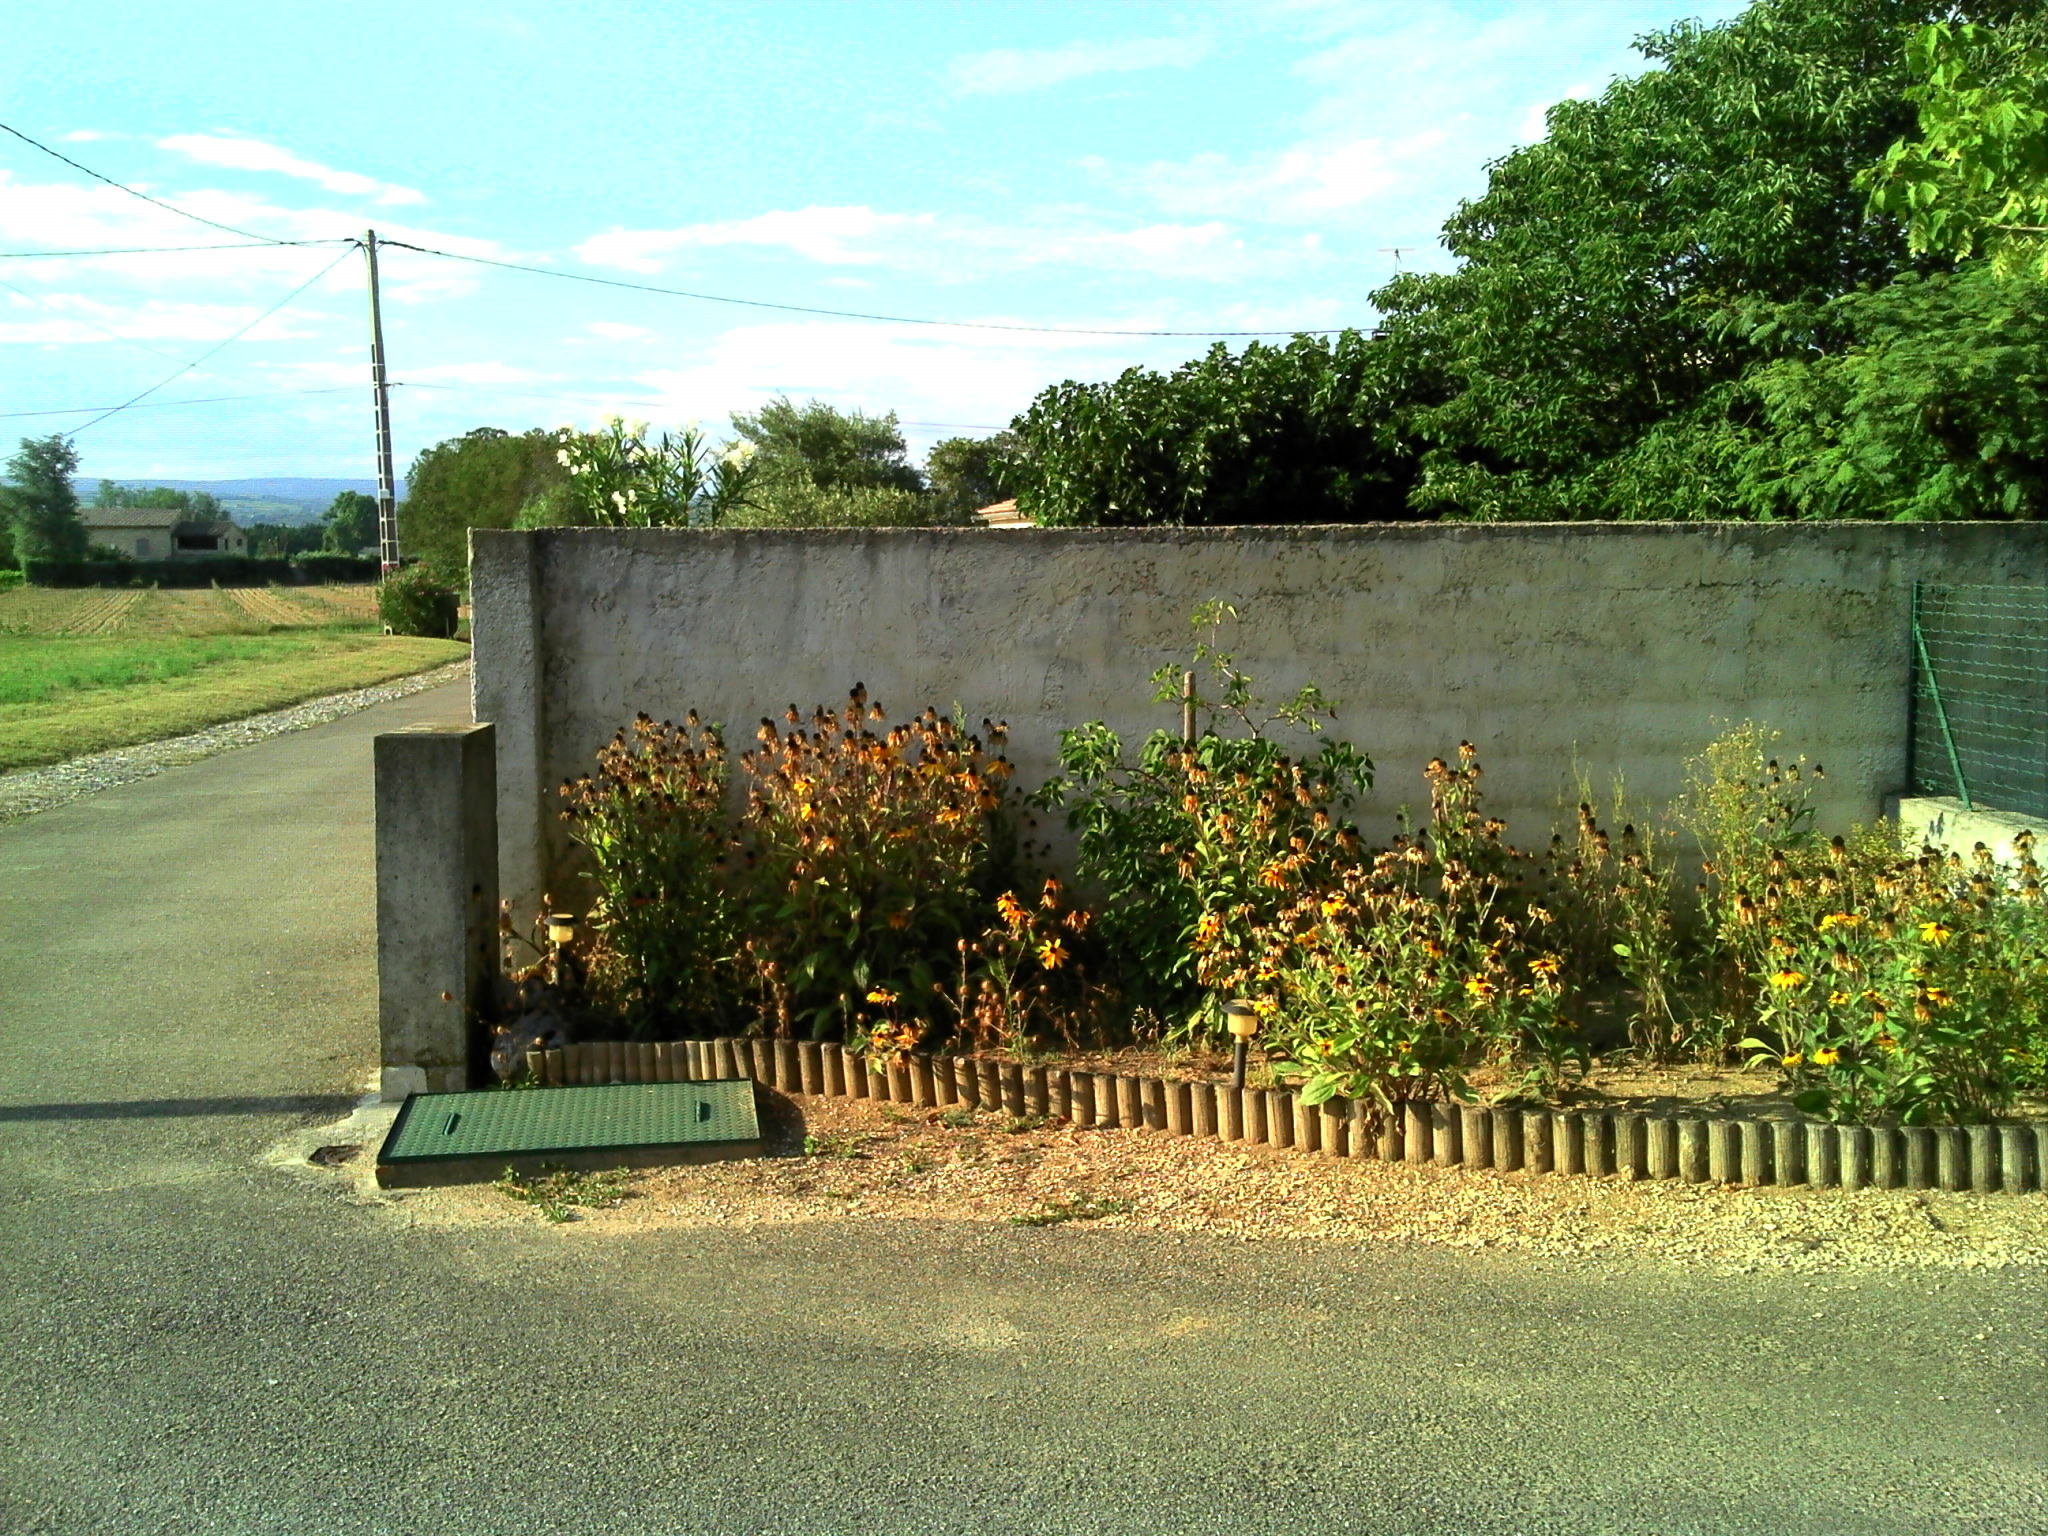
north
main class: Grassland
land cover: Grassland with sparse tree/shrub cover
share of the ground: > 75 %
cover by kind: herbaceous plants 85 %, consolidated bare surface 10 %, broadleaved forest trees 5 %
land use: Residential
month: August
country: FR
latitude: 44.2646
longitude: 4.6085
